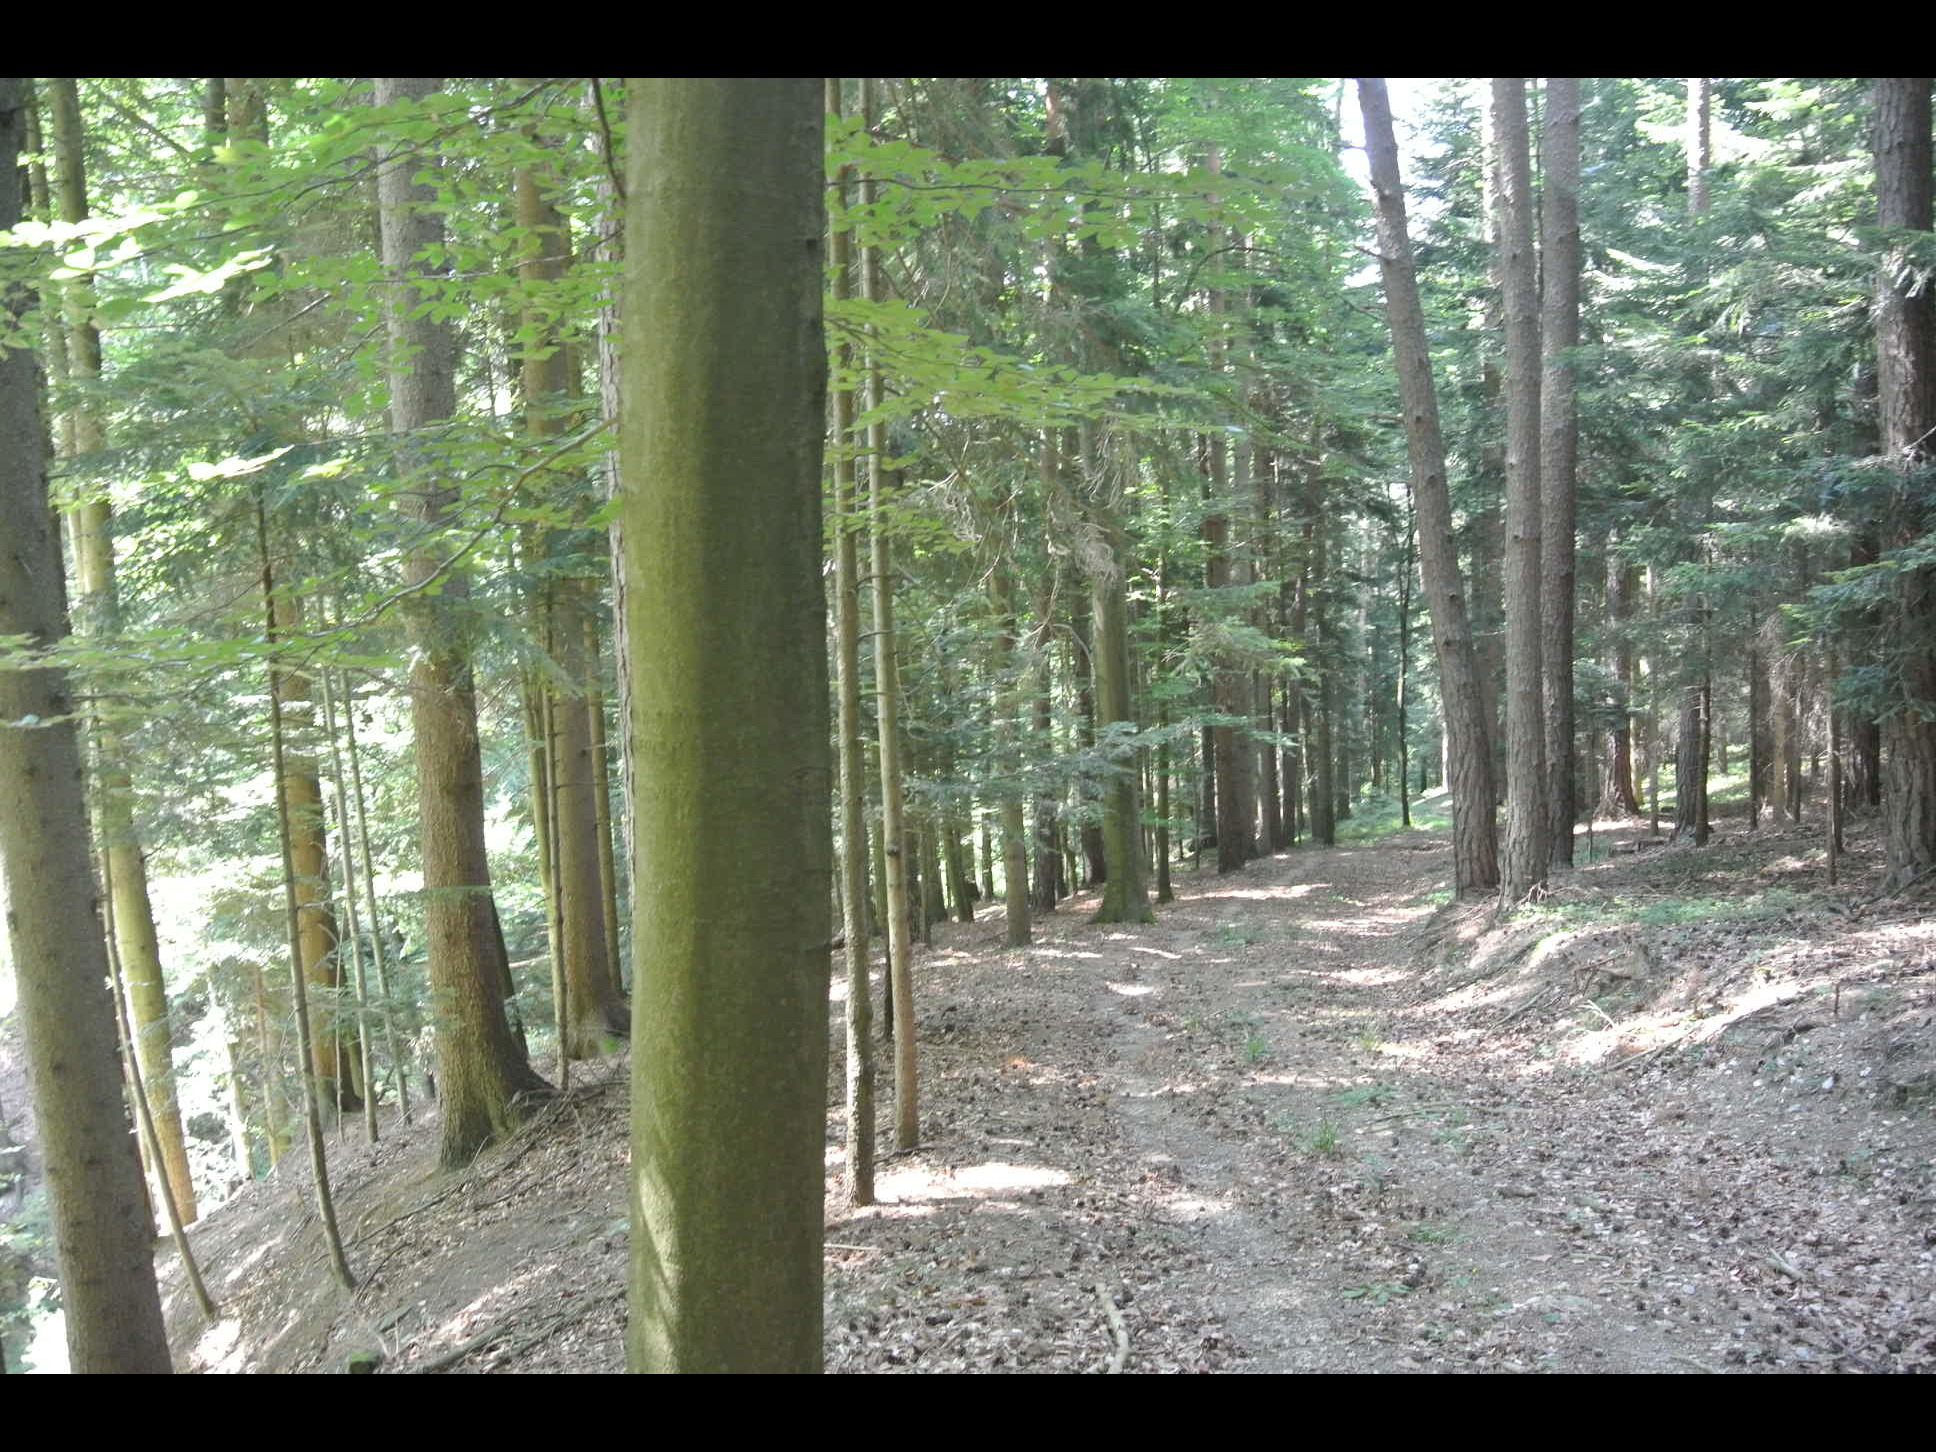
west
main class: Woodland
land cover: Other mixed woodland
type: alpine coniferous forest
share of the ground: > 75 %
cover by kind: coniferous forest trees 60 %, broadleaved forest trees 35 %, herbaceous plants 5 %
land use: Forestry
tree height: > 5 m
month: July
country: AT
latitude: 47.6344
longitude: 16.1918
